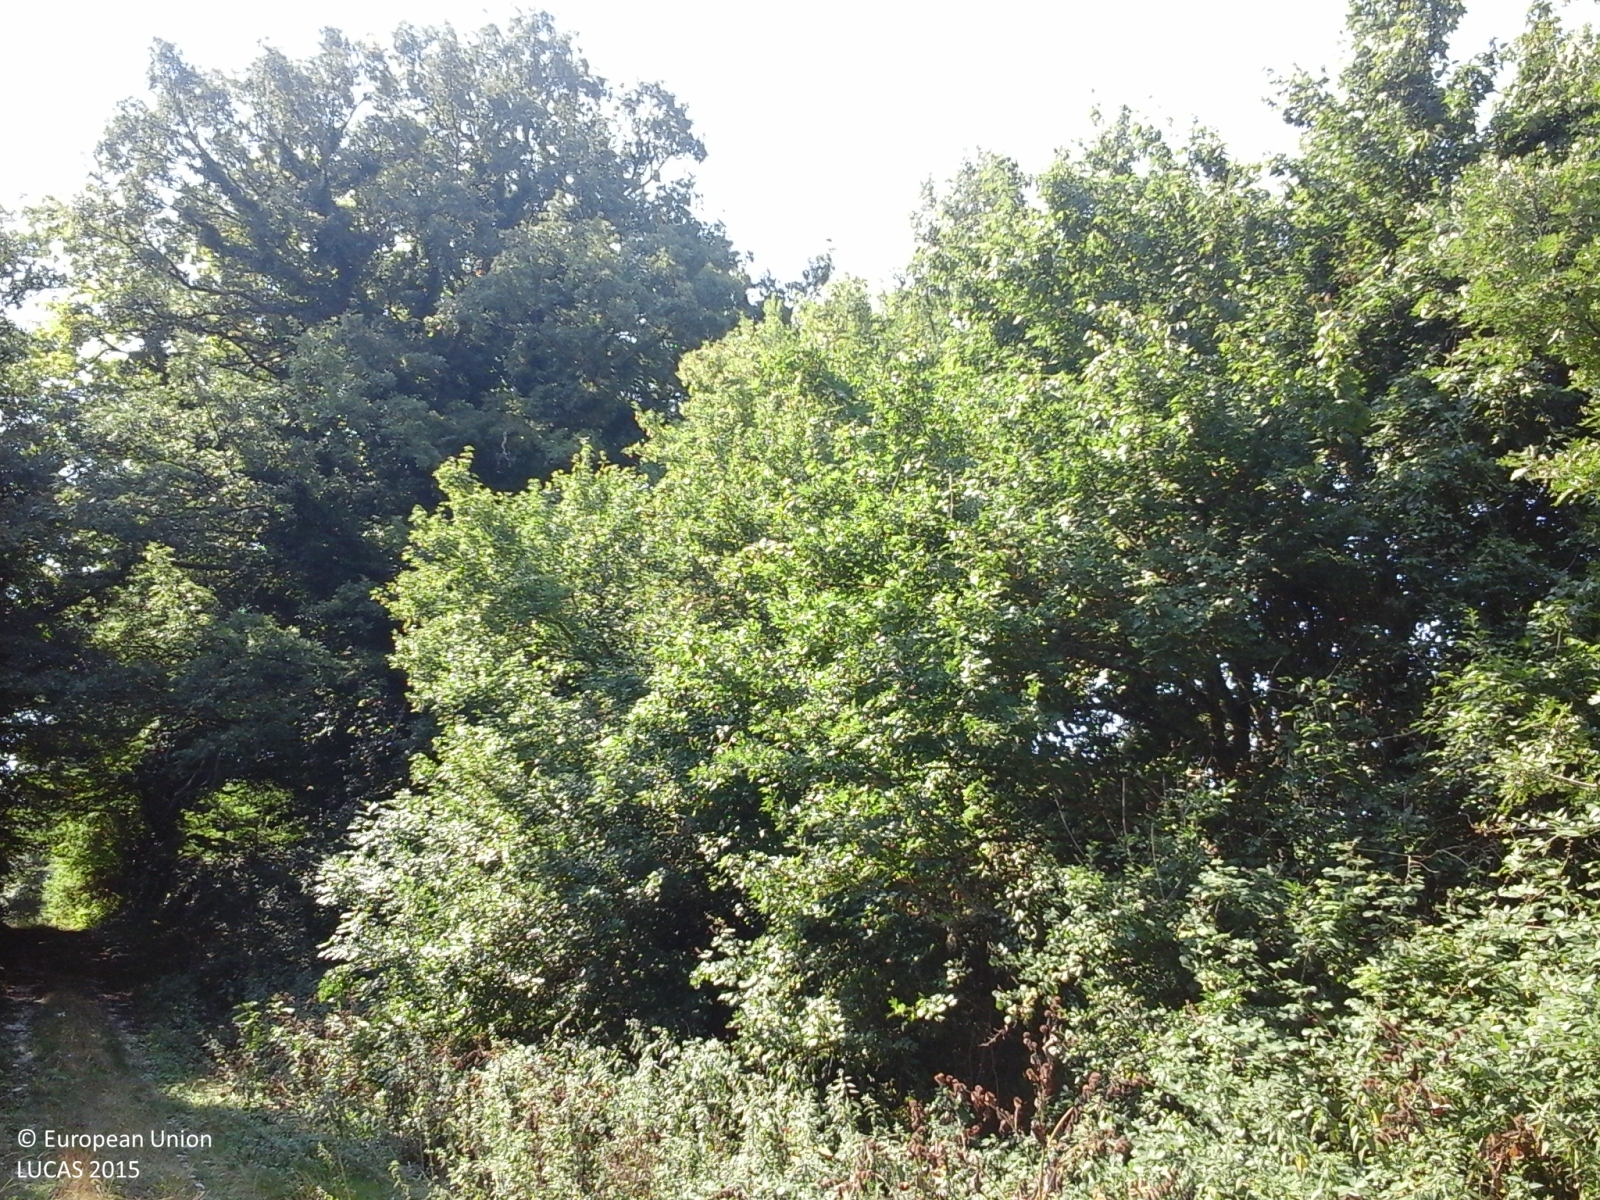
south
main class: Woodland
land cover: Broadleaved woodland
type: thermophilous deciduous forest
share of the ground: > 75 %
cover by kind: broadleaved forest trees 80 %, shrubs 15 %, herbaceous plants 5 %
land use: Forestry
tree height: > 5 m
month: August
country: IT
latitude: 41.3484
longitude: 15.1093
